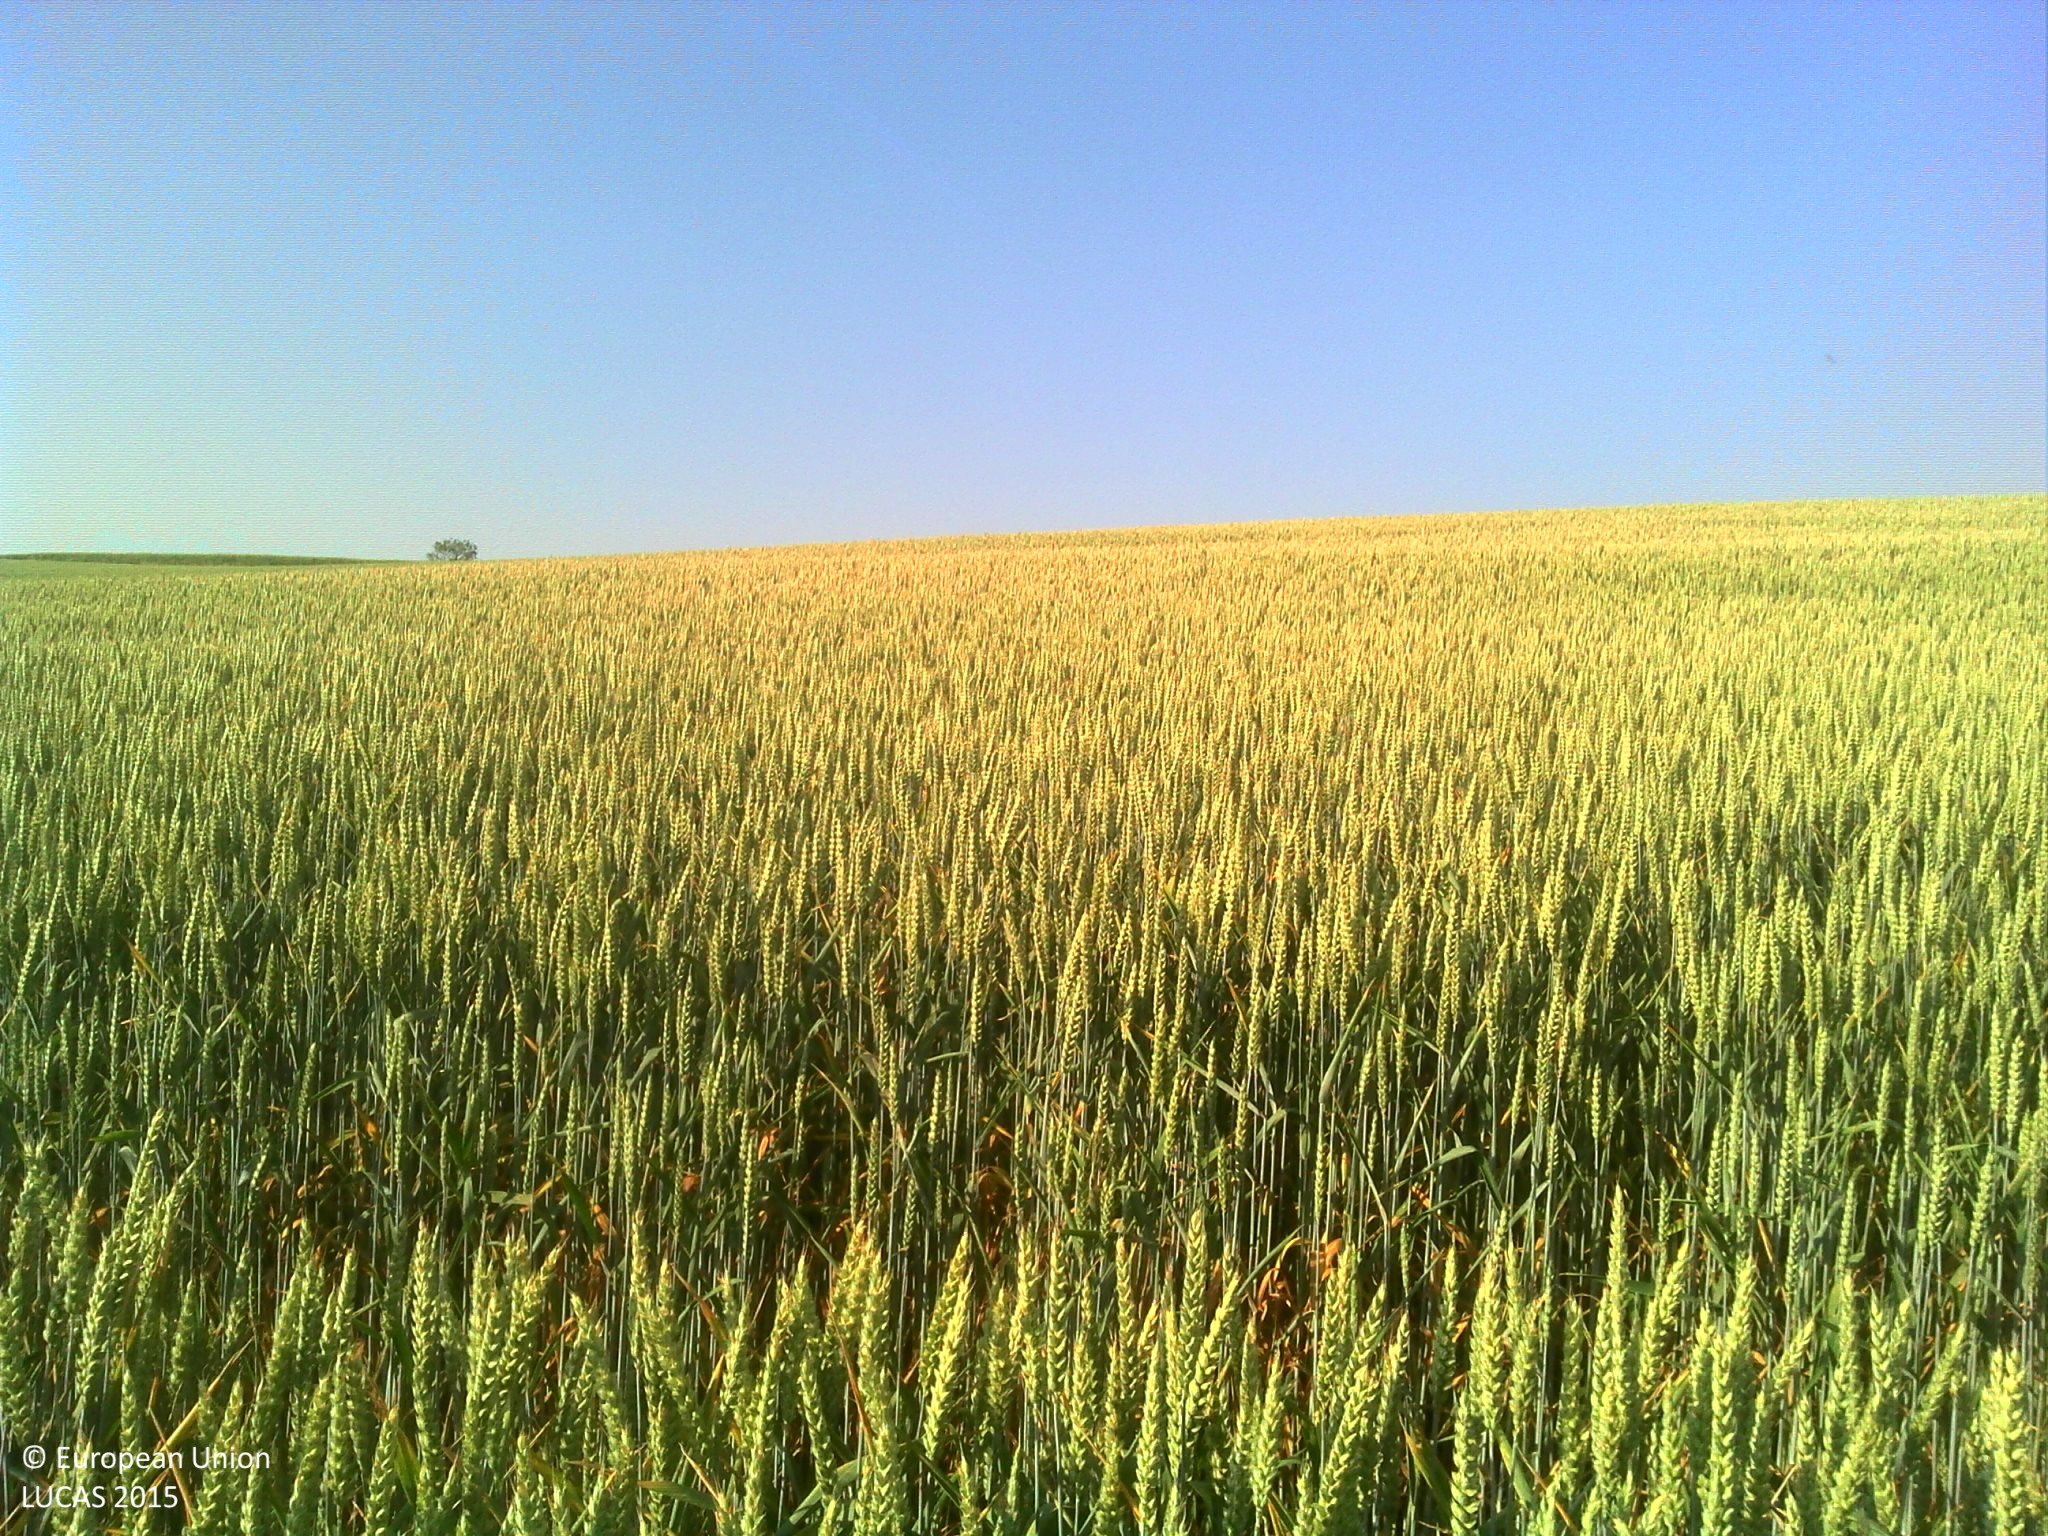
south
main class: Cropland
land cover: Common wheat
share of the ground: > 75 %
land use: Agriculture (excluding fallow land and kitchen gardens)
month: June
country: FR
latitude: 43.8860
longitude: 2.1000
